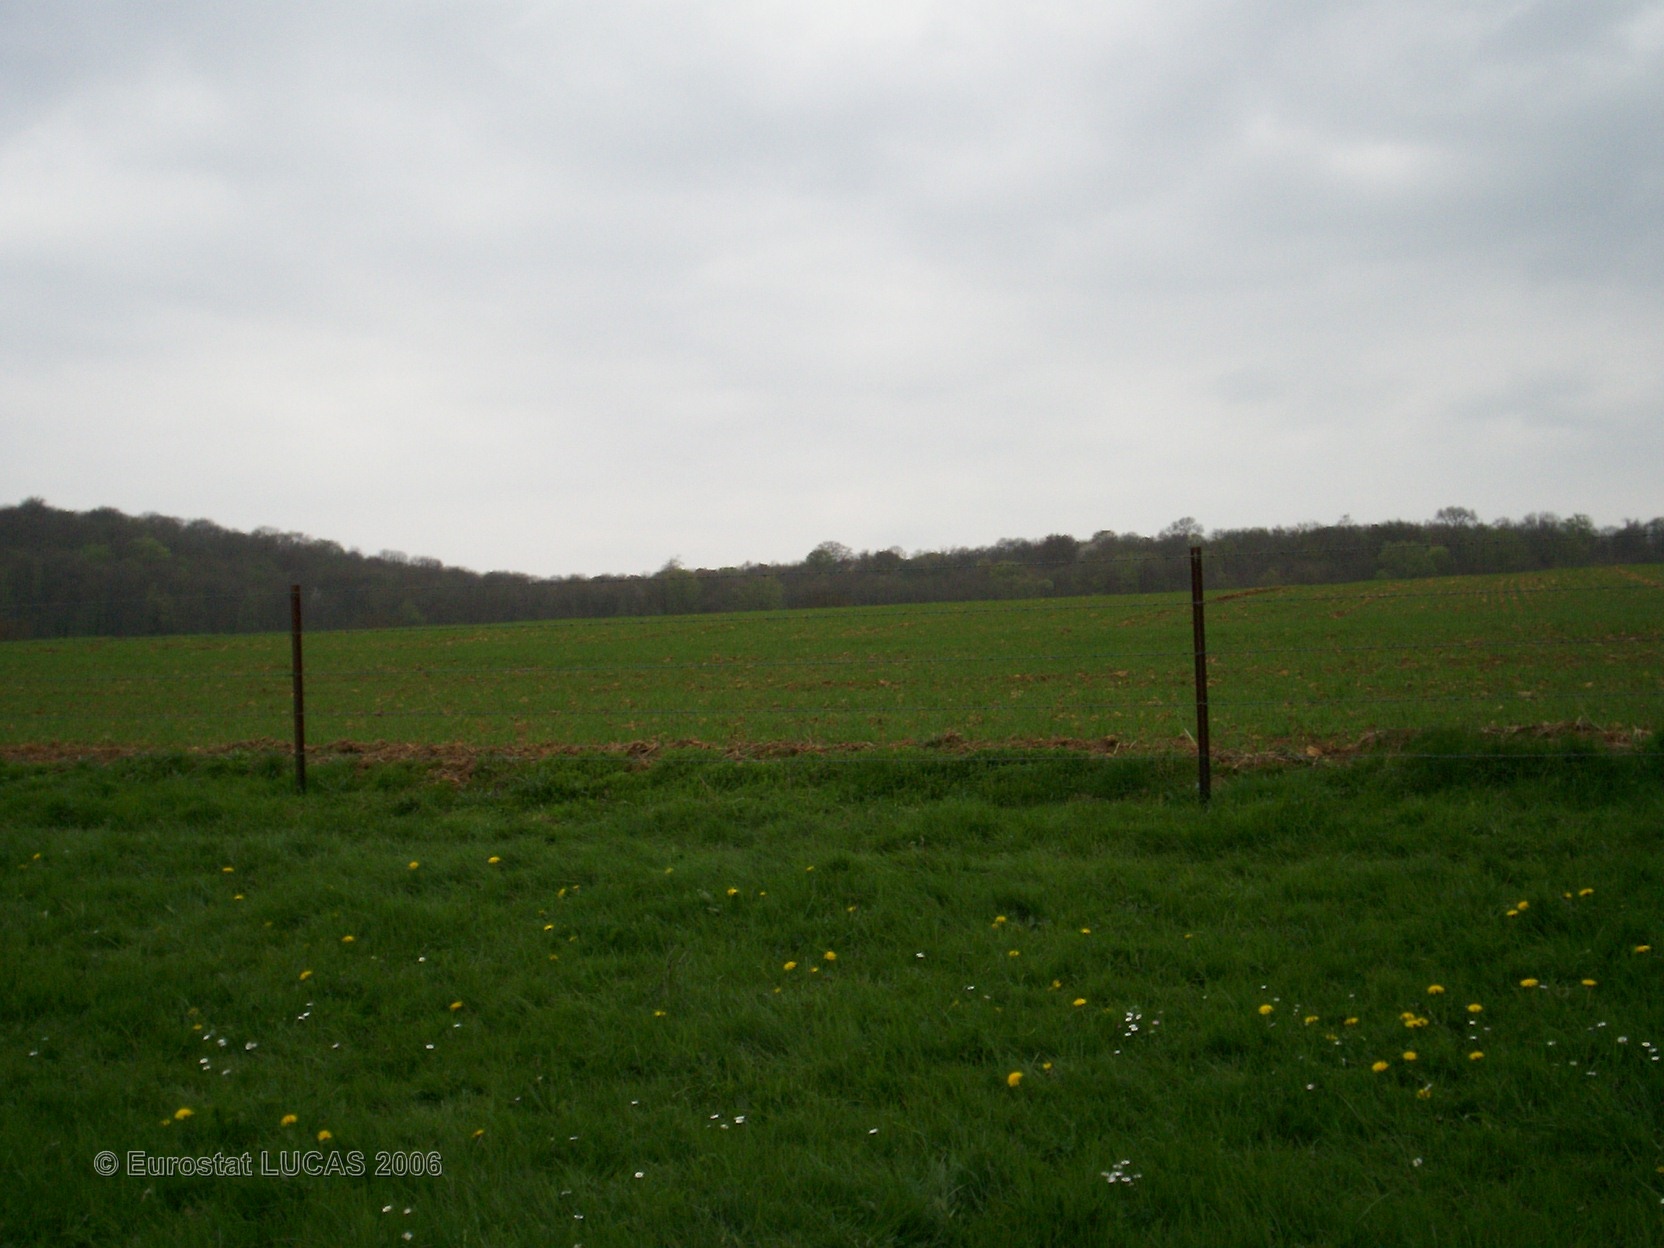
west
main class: Grassland
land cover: Grassland without tree/shrub cover
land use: Agriculture (excluding fallow land and kitchen gardens)
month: April
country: FR
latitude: 49.7651
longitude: 4.5401
